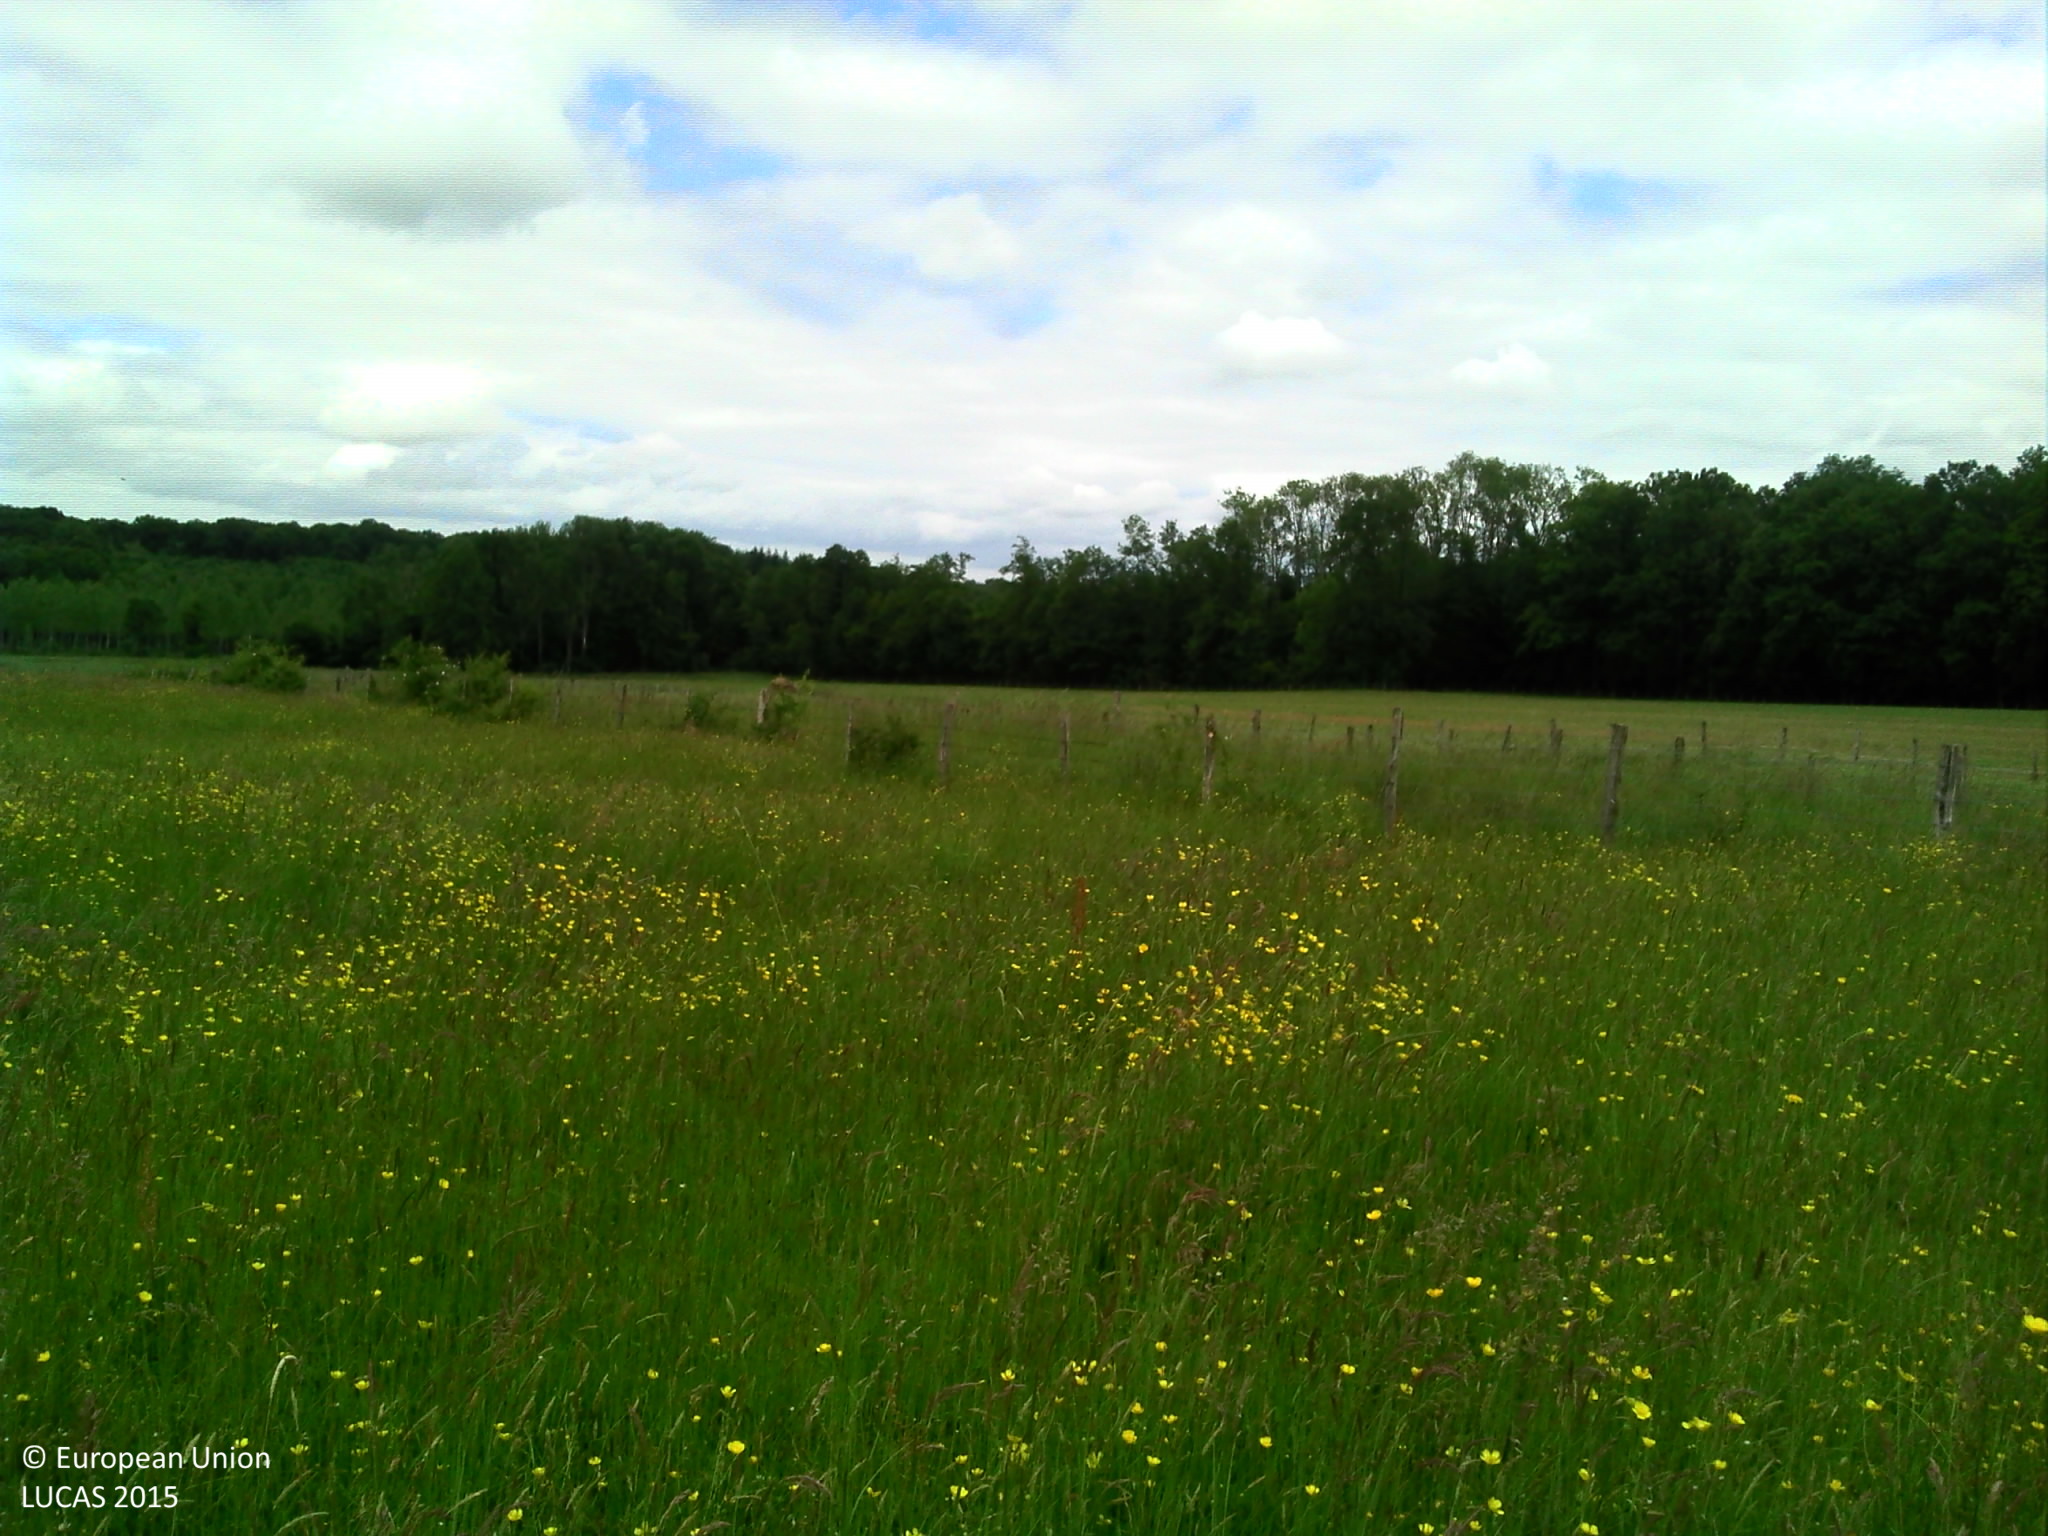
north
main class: Grassland
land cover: Grassland without tree/shrub cover
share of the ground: > 75 %
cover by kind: herbaceous plants 100 %
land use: Agriculture (excluding fallow land and kitchen gardens)
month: June
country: FR
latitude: 48.5187
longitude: 4.8669
